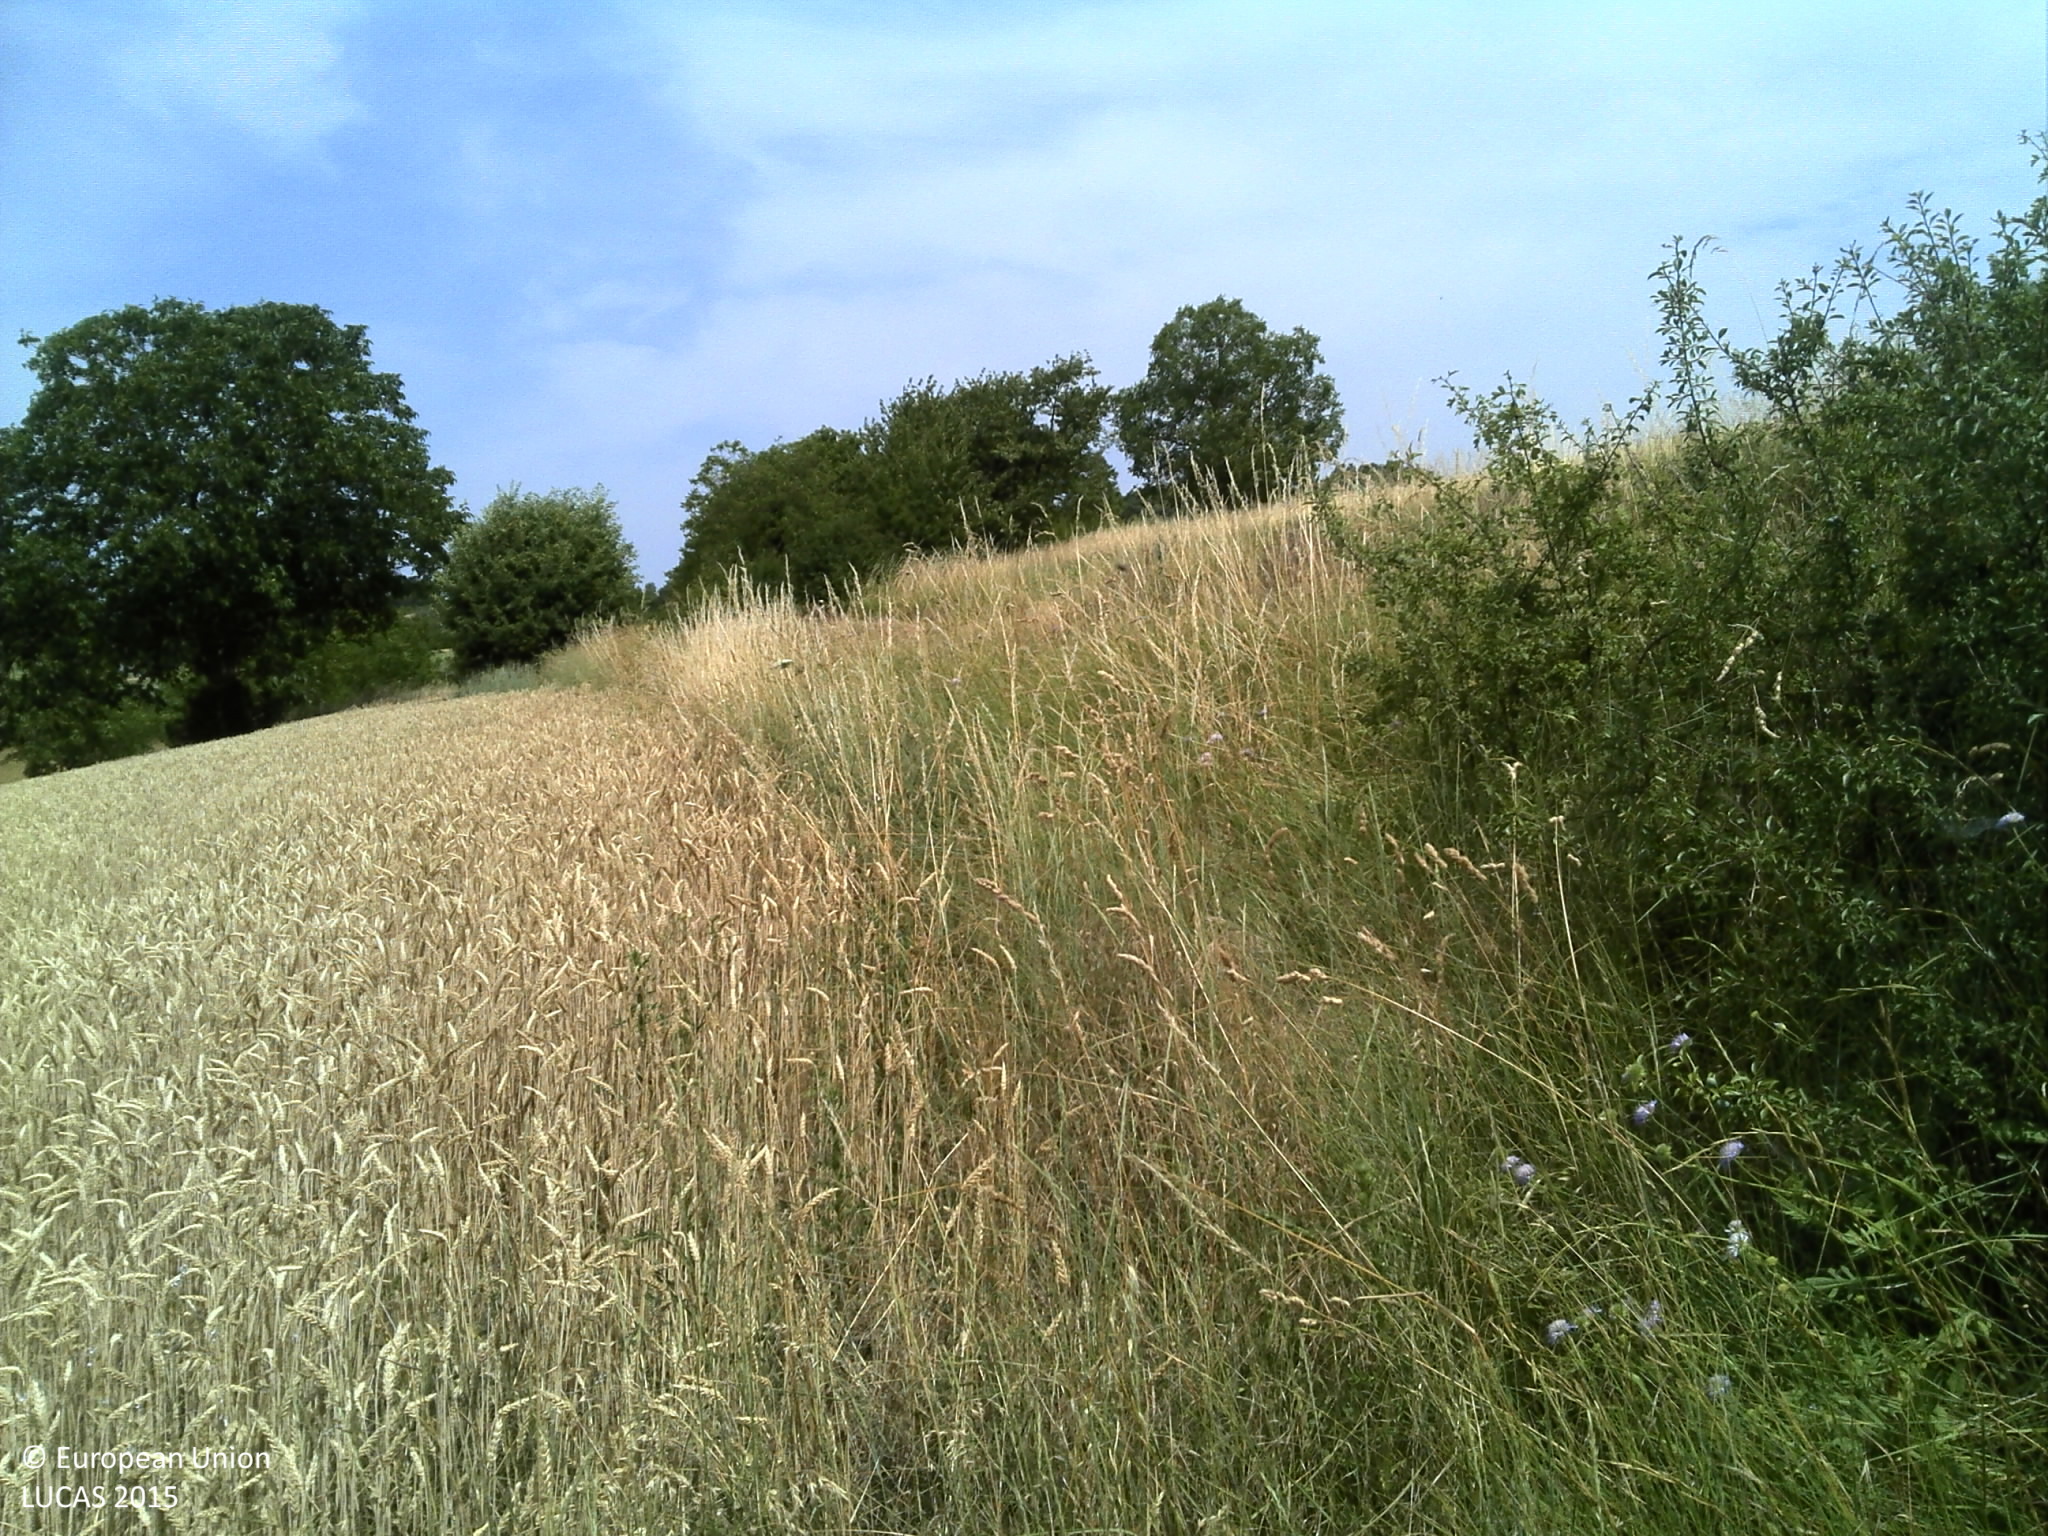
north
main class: Cropland
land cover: Common wheat
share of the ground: > 75 %
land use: Agriculture (excluding fallow land and kitchen gardens)
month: July
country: FR
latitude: 45.9654
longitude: 3.3801
